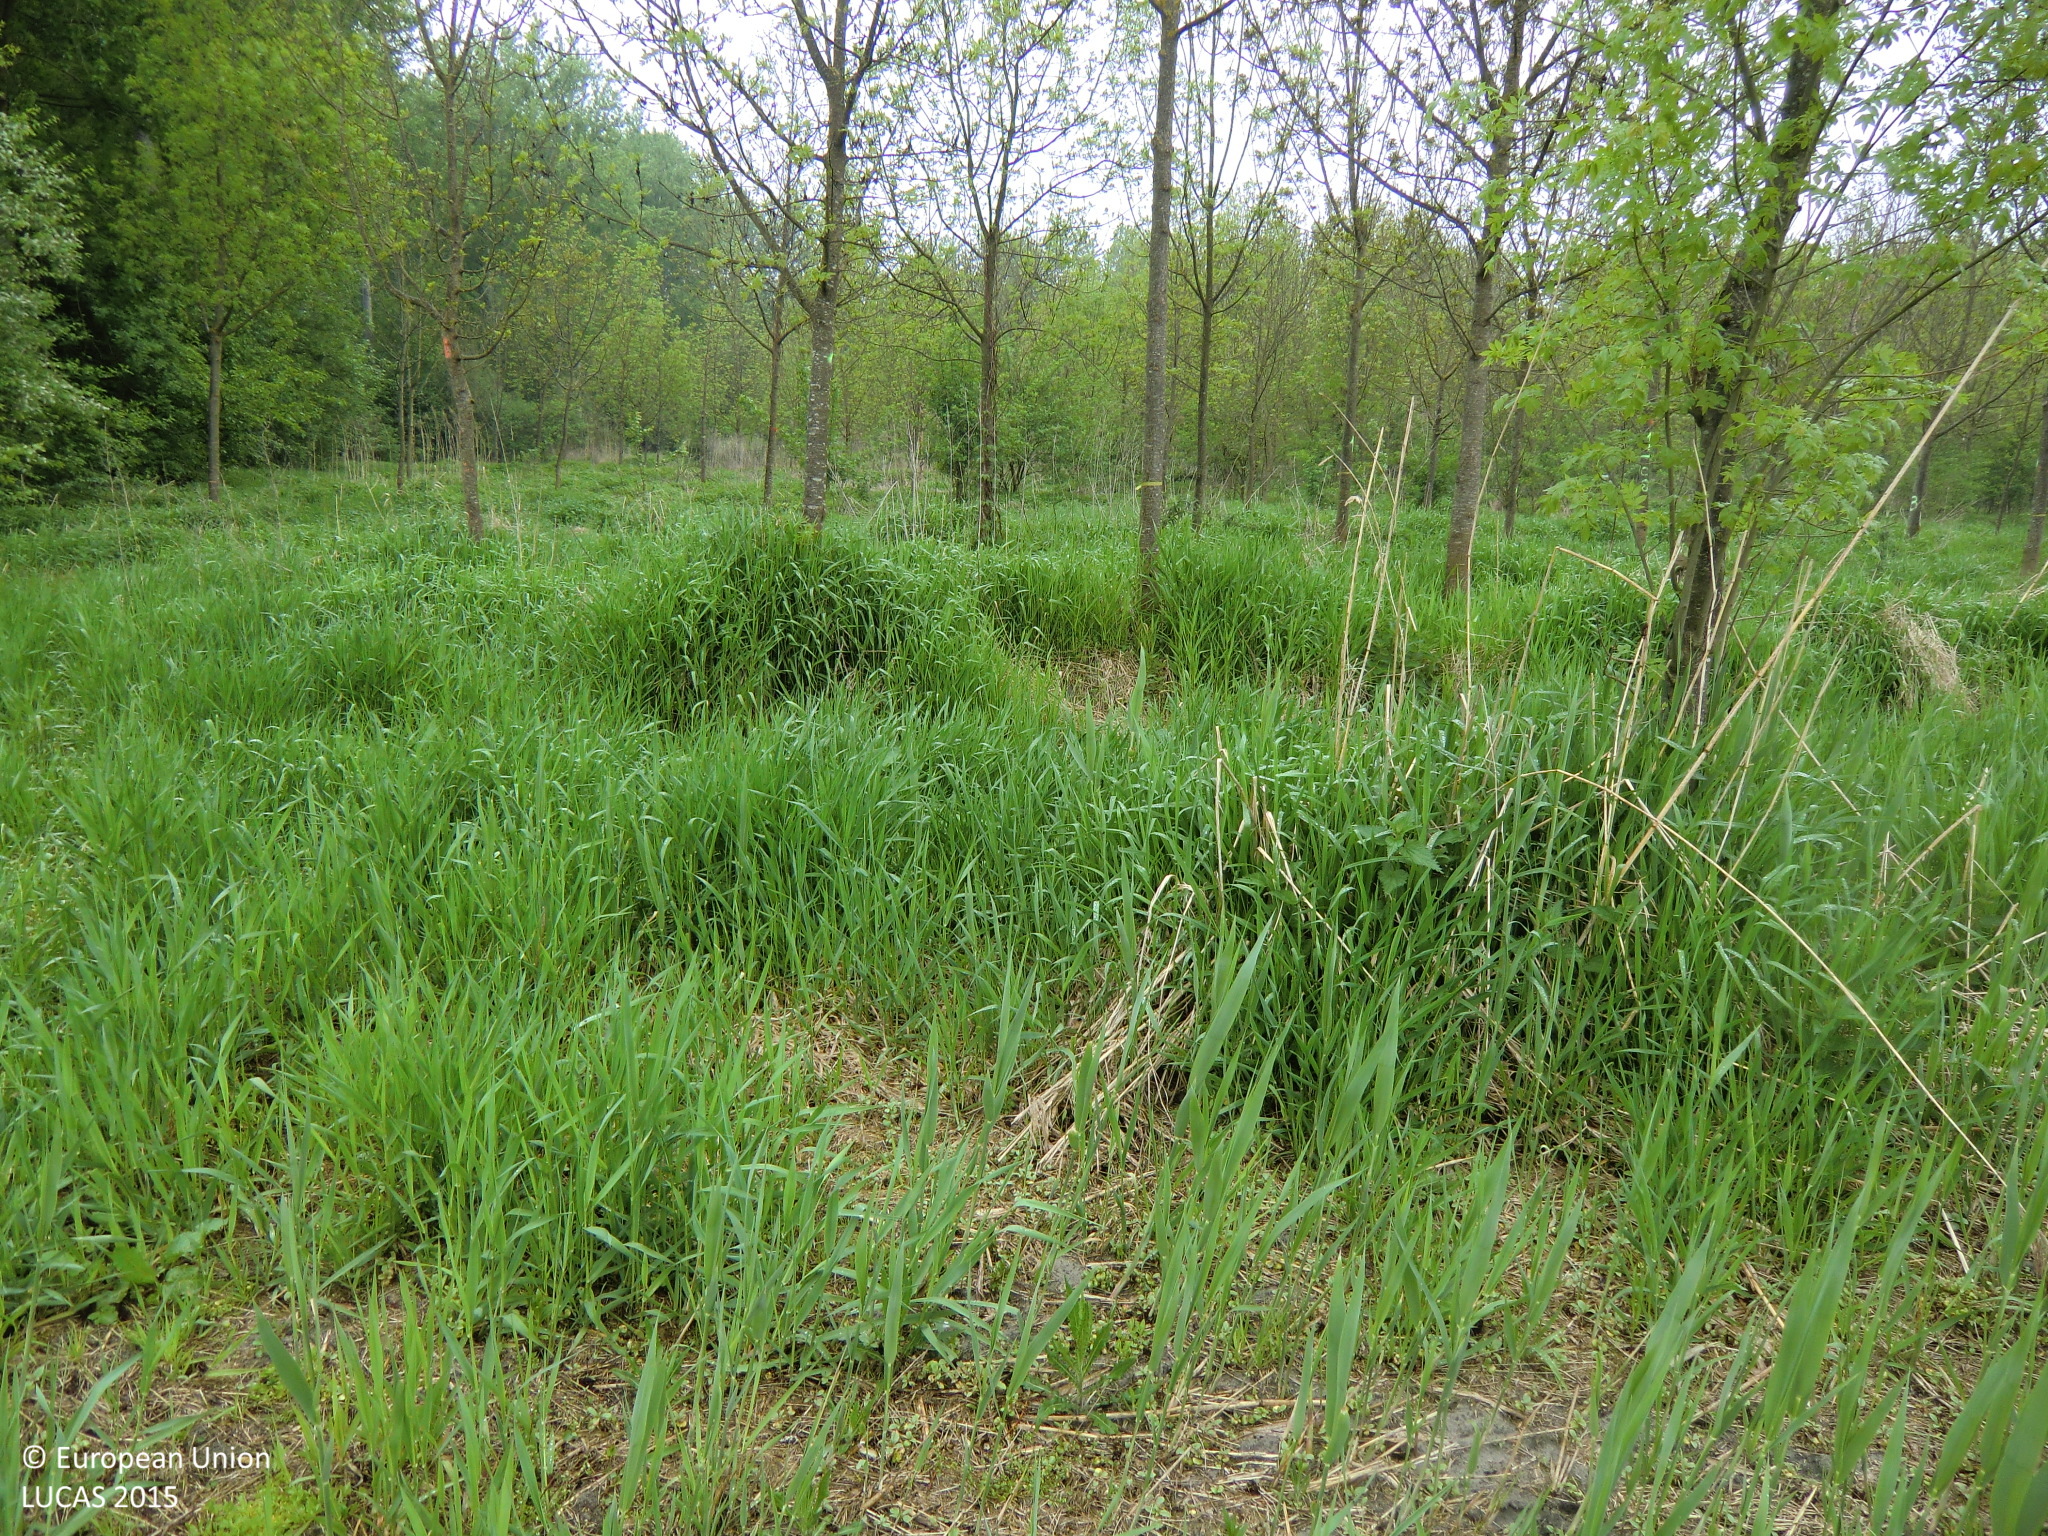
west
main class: Cropland
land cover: Nurseries
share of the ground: < 10 %
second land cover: Spontaneously vegetated surfaces
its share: > 75 %
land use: Forestry
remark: Temporary flooded
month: May
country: AT
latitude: 48.1765
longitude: 14.7210
